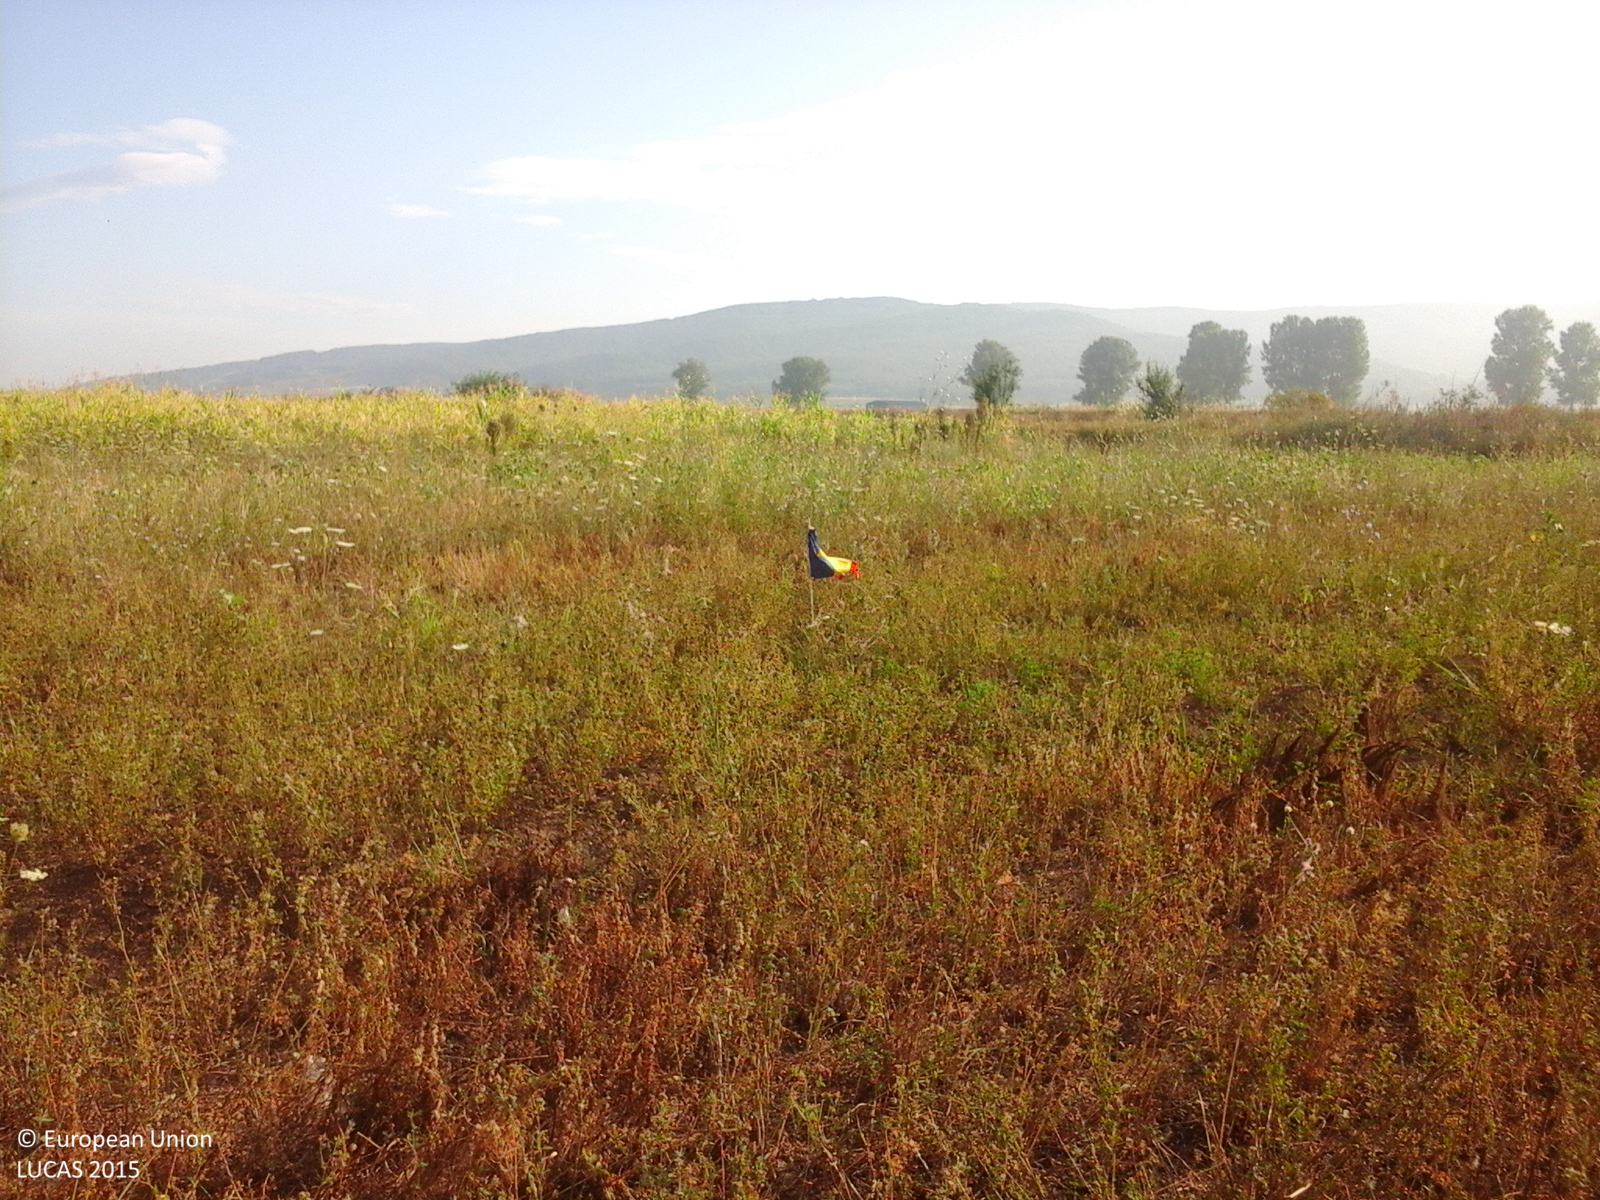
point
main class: Cropland
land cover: Lucerne
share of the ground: > 75 %
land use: Agriculture (excluding fallow land and kitchen gardens)
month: July
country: RO
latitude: 46.1147
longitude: 27.2444
